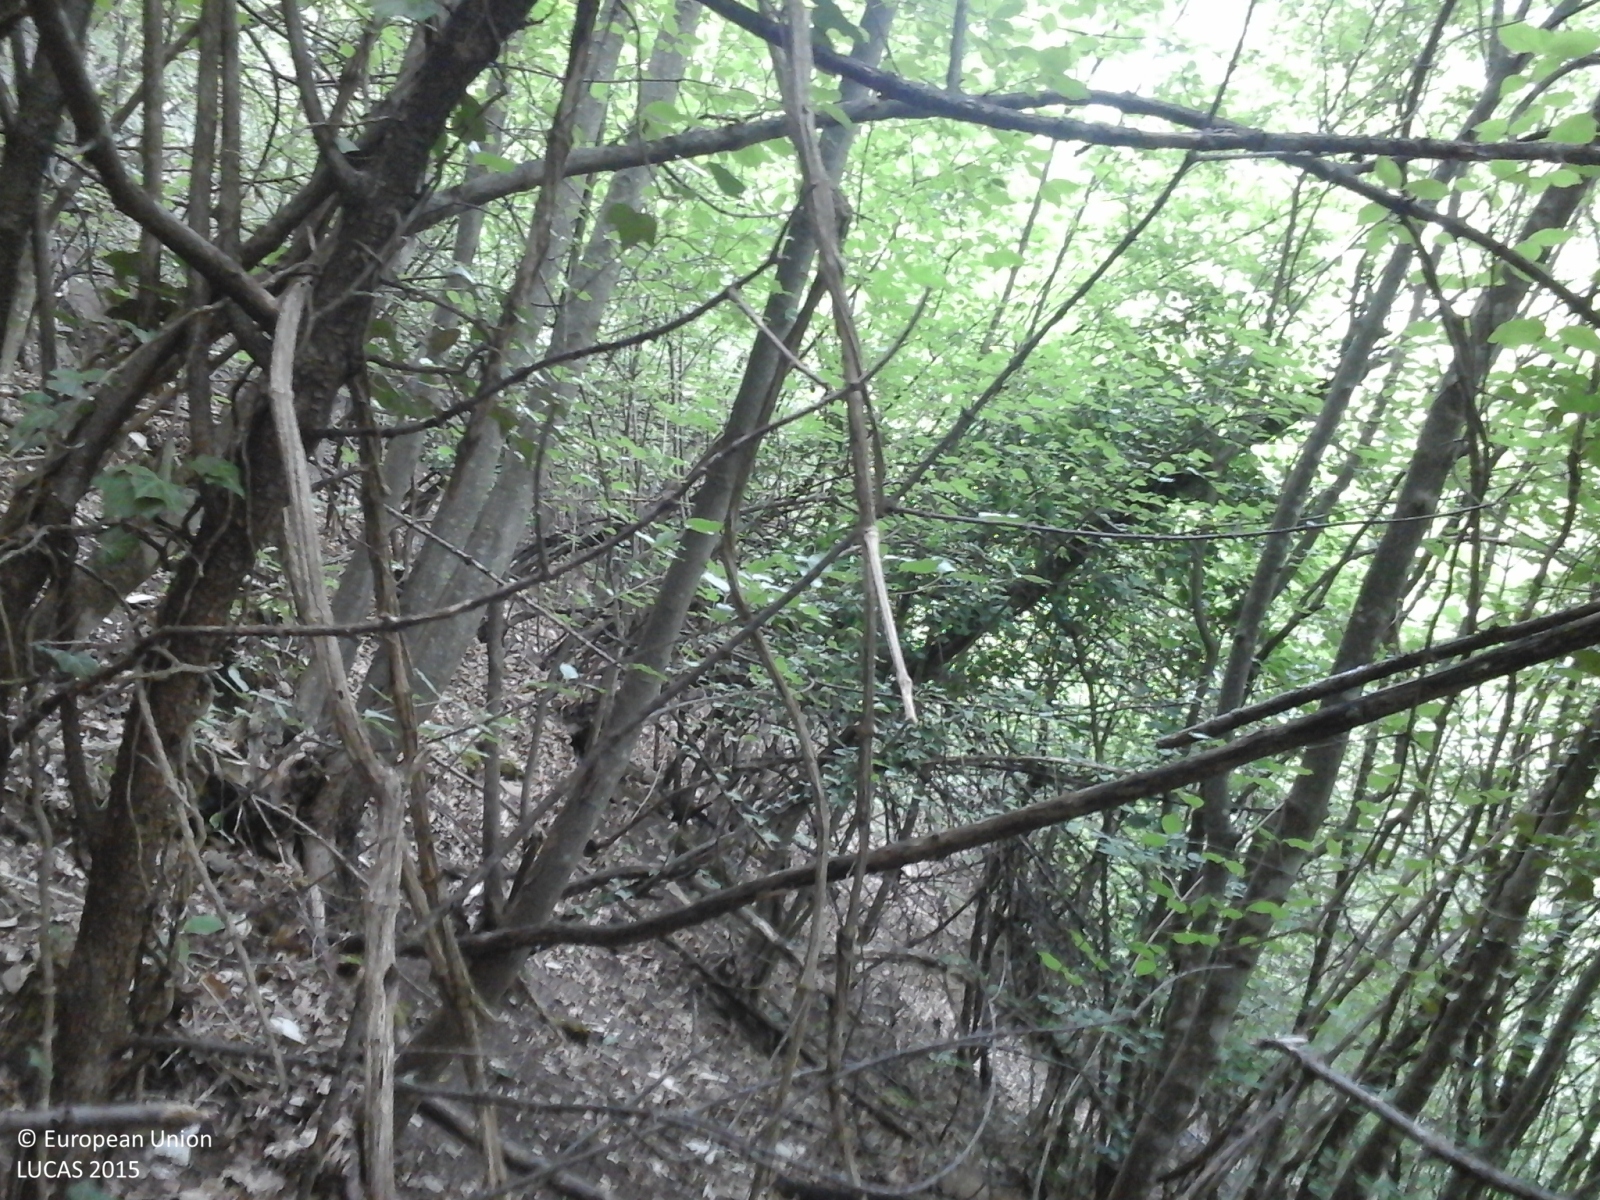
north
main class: Woodland
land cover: Broadleaved woodland
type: thermophilous deciduous forest
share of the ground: > 75 %
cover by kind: broadleaved forest trees 95 %, shrubs 5 %
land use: Forestry
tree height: > 5 m
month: June
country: IT
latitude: 44.6718
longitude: 9.1567
